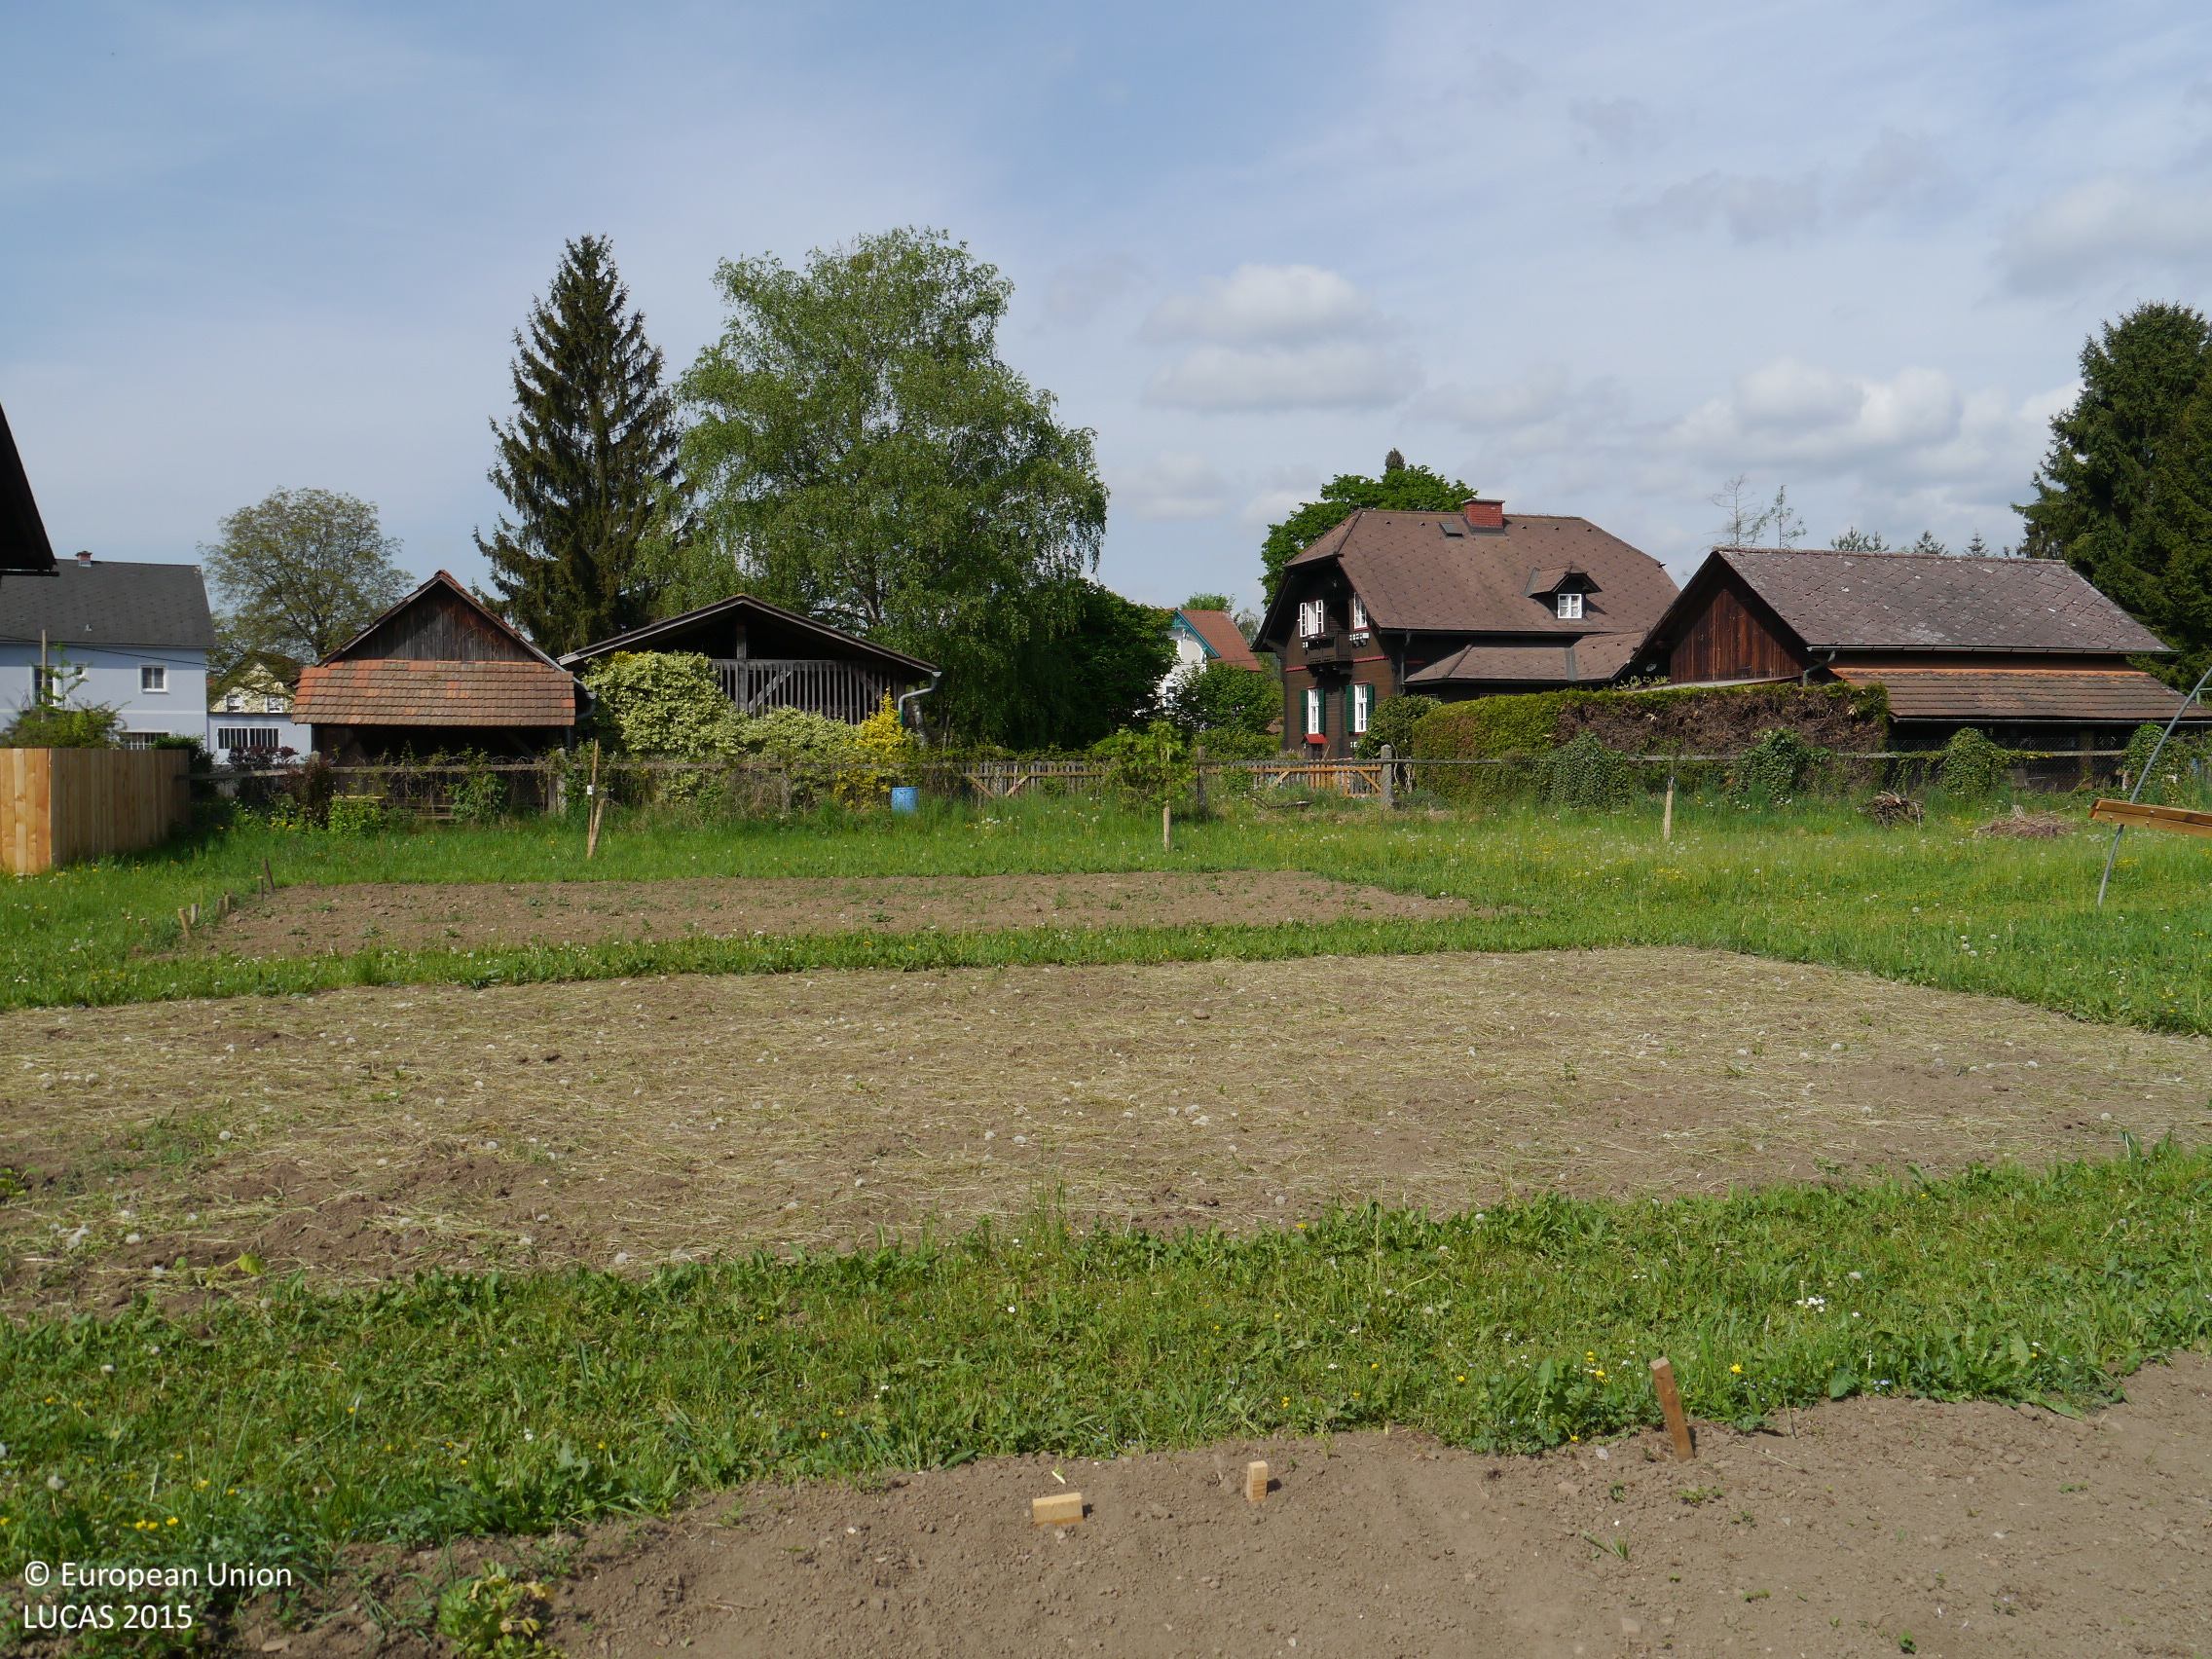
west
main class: Cropland
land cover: Other fresh vegetables
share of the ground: 50 - 75 %
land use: Kitchen garden
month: May
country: AT
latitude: 47.1202
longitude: 15.3379
